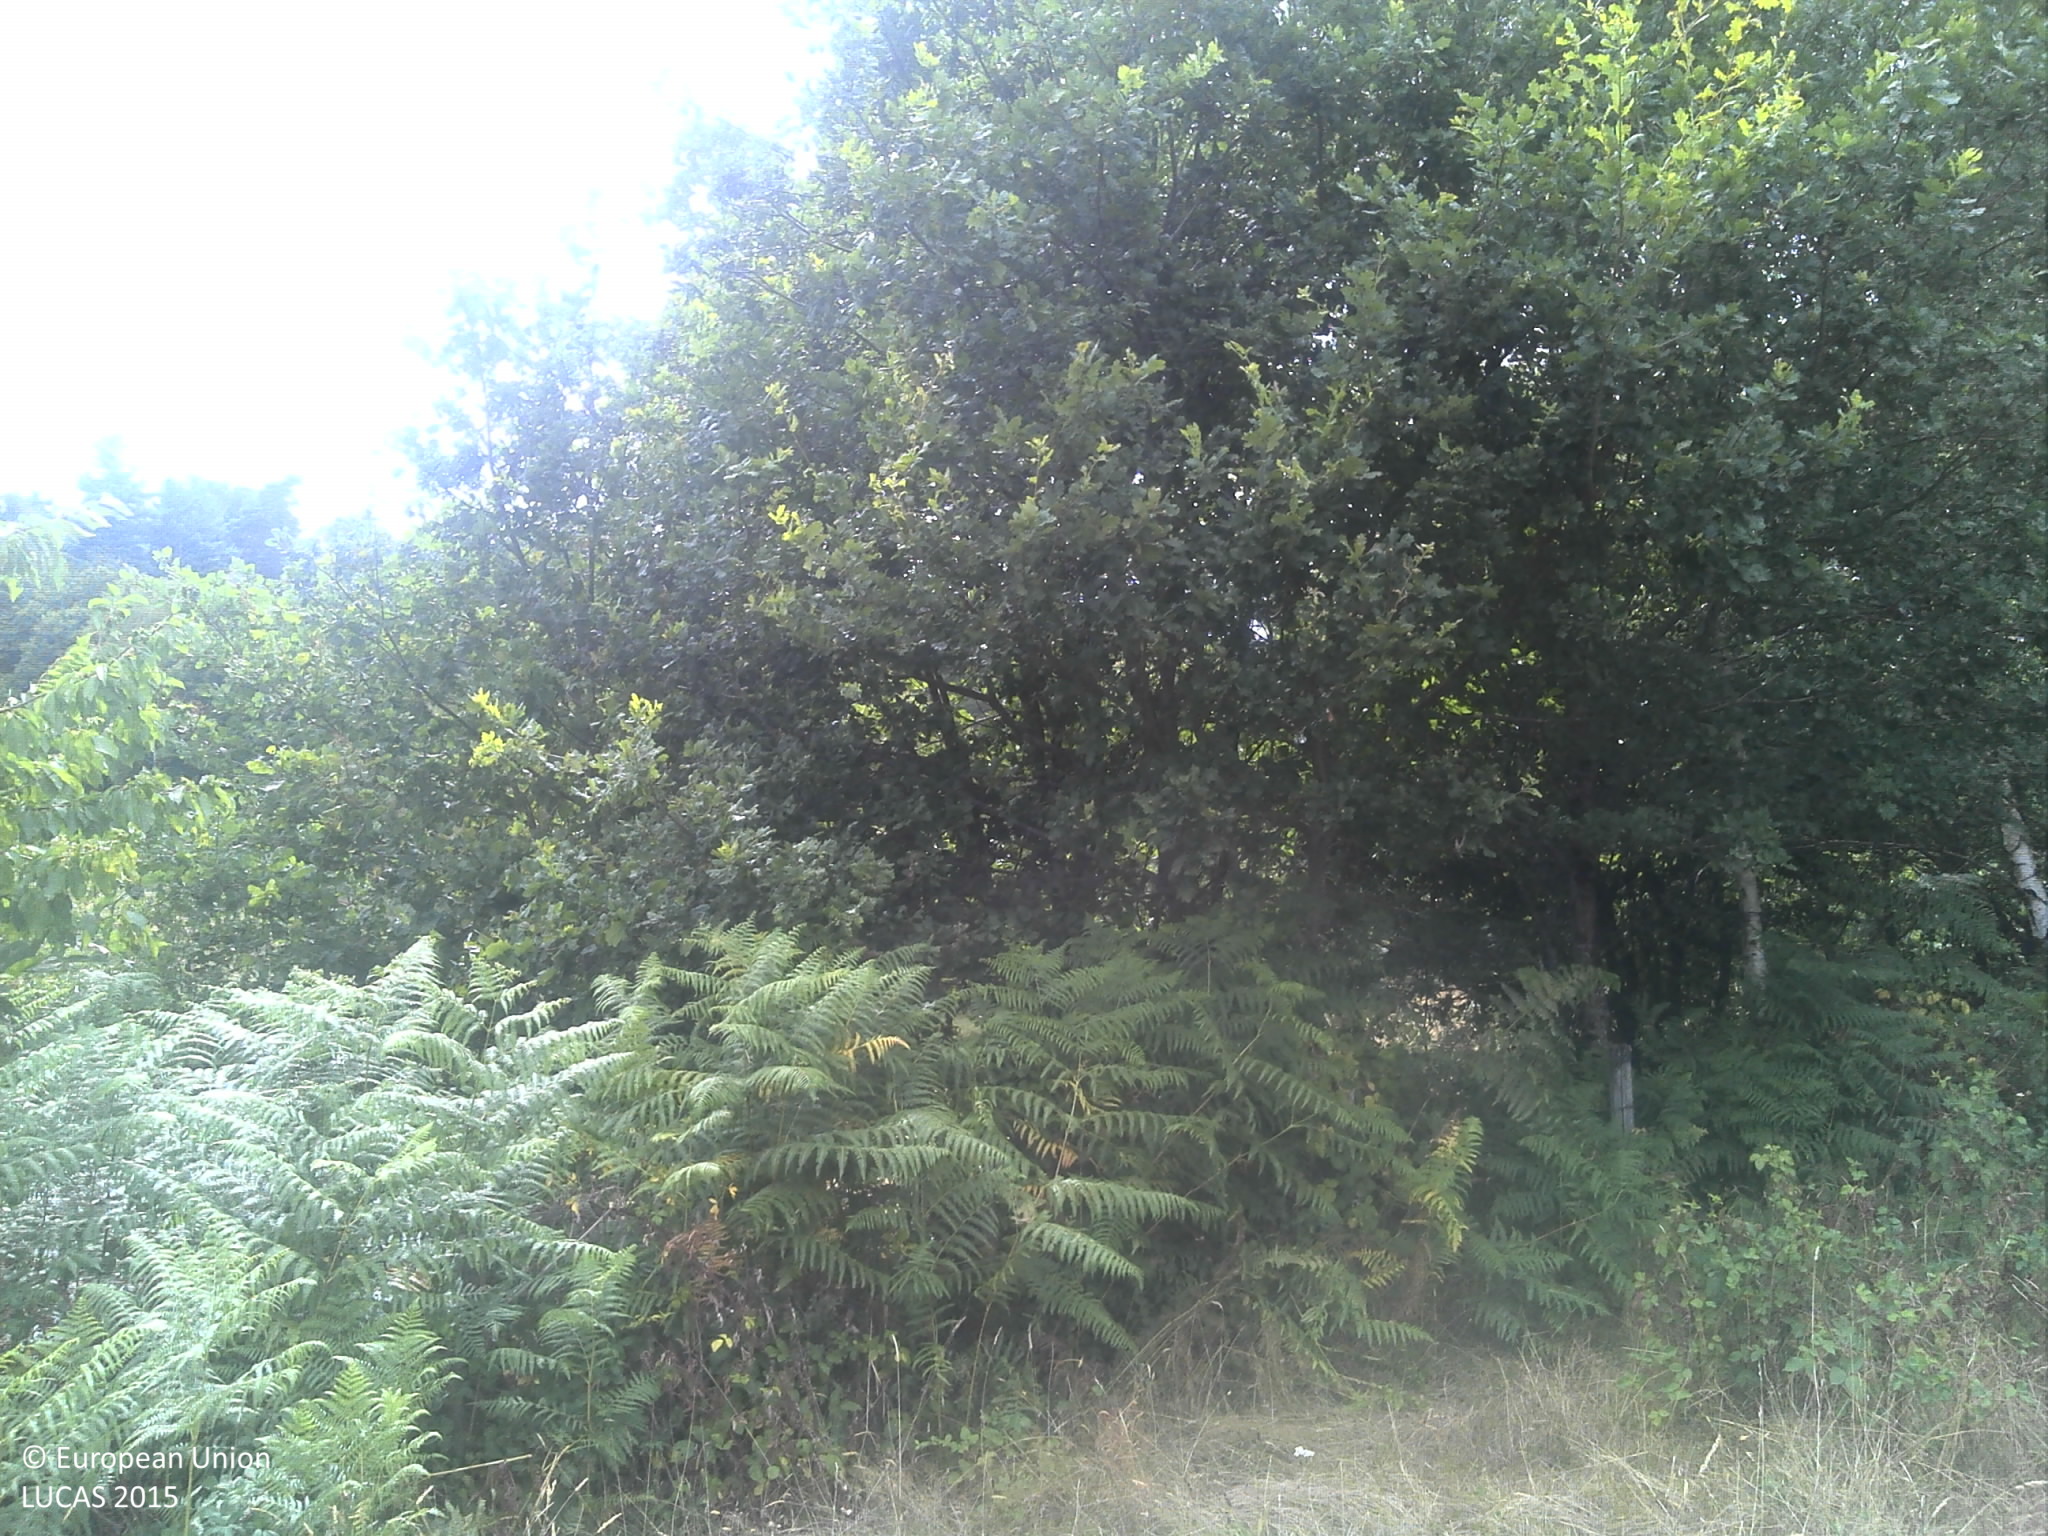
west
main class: Grassland
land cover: Grassland without tree/shrub cover
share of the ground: > 75 %
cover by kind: herbaceous plants 100 %
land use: Agriculture (excluding fallow land and kitchen gardens)
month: July
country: FR
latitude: 45.1760
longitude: 1.9169
